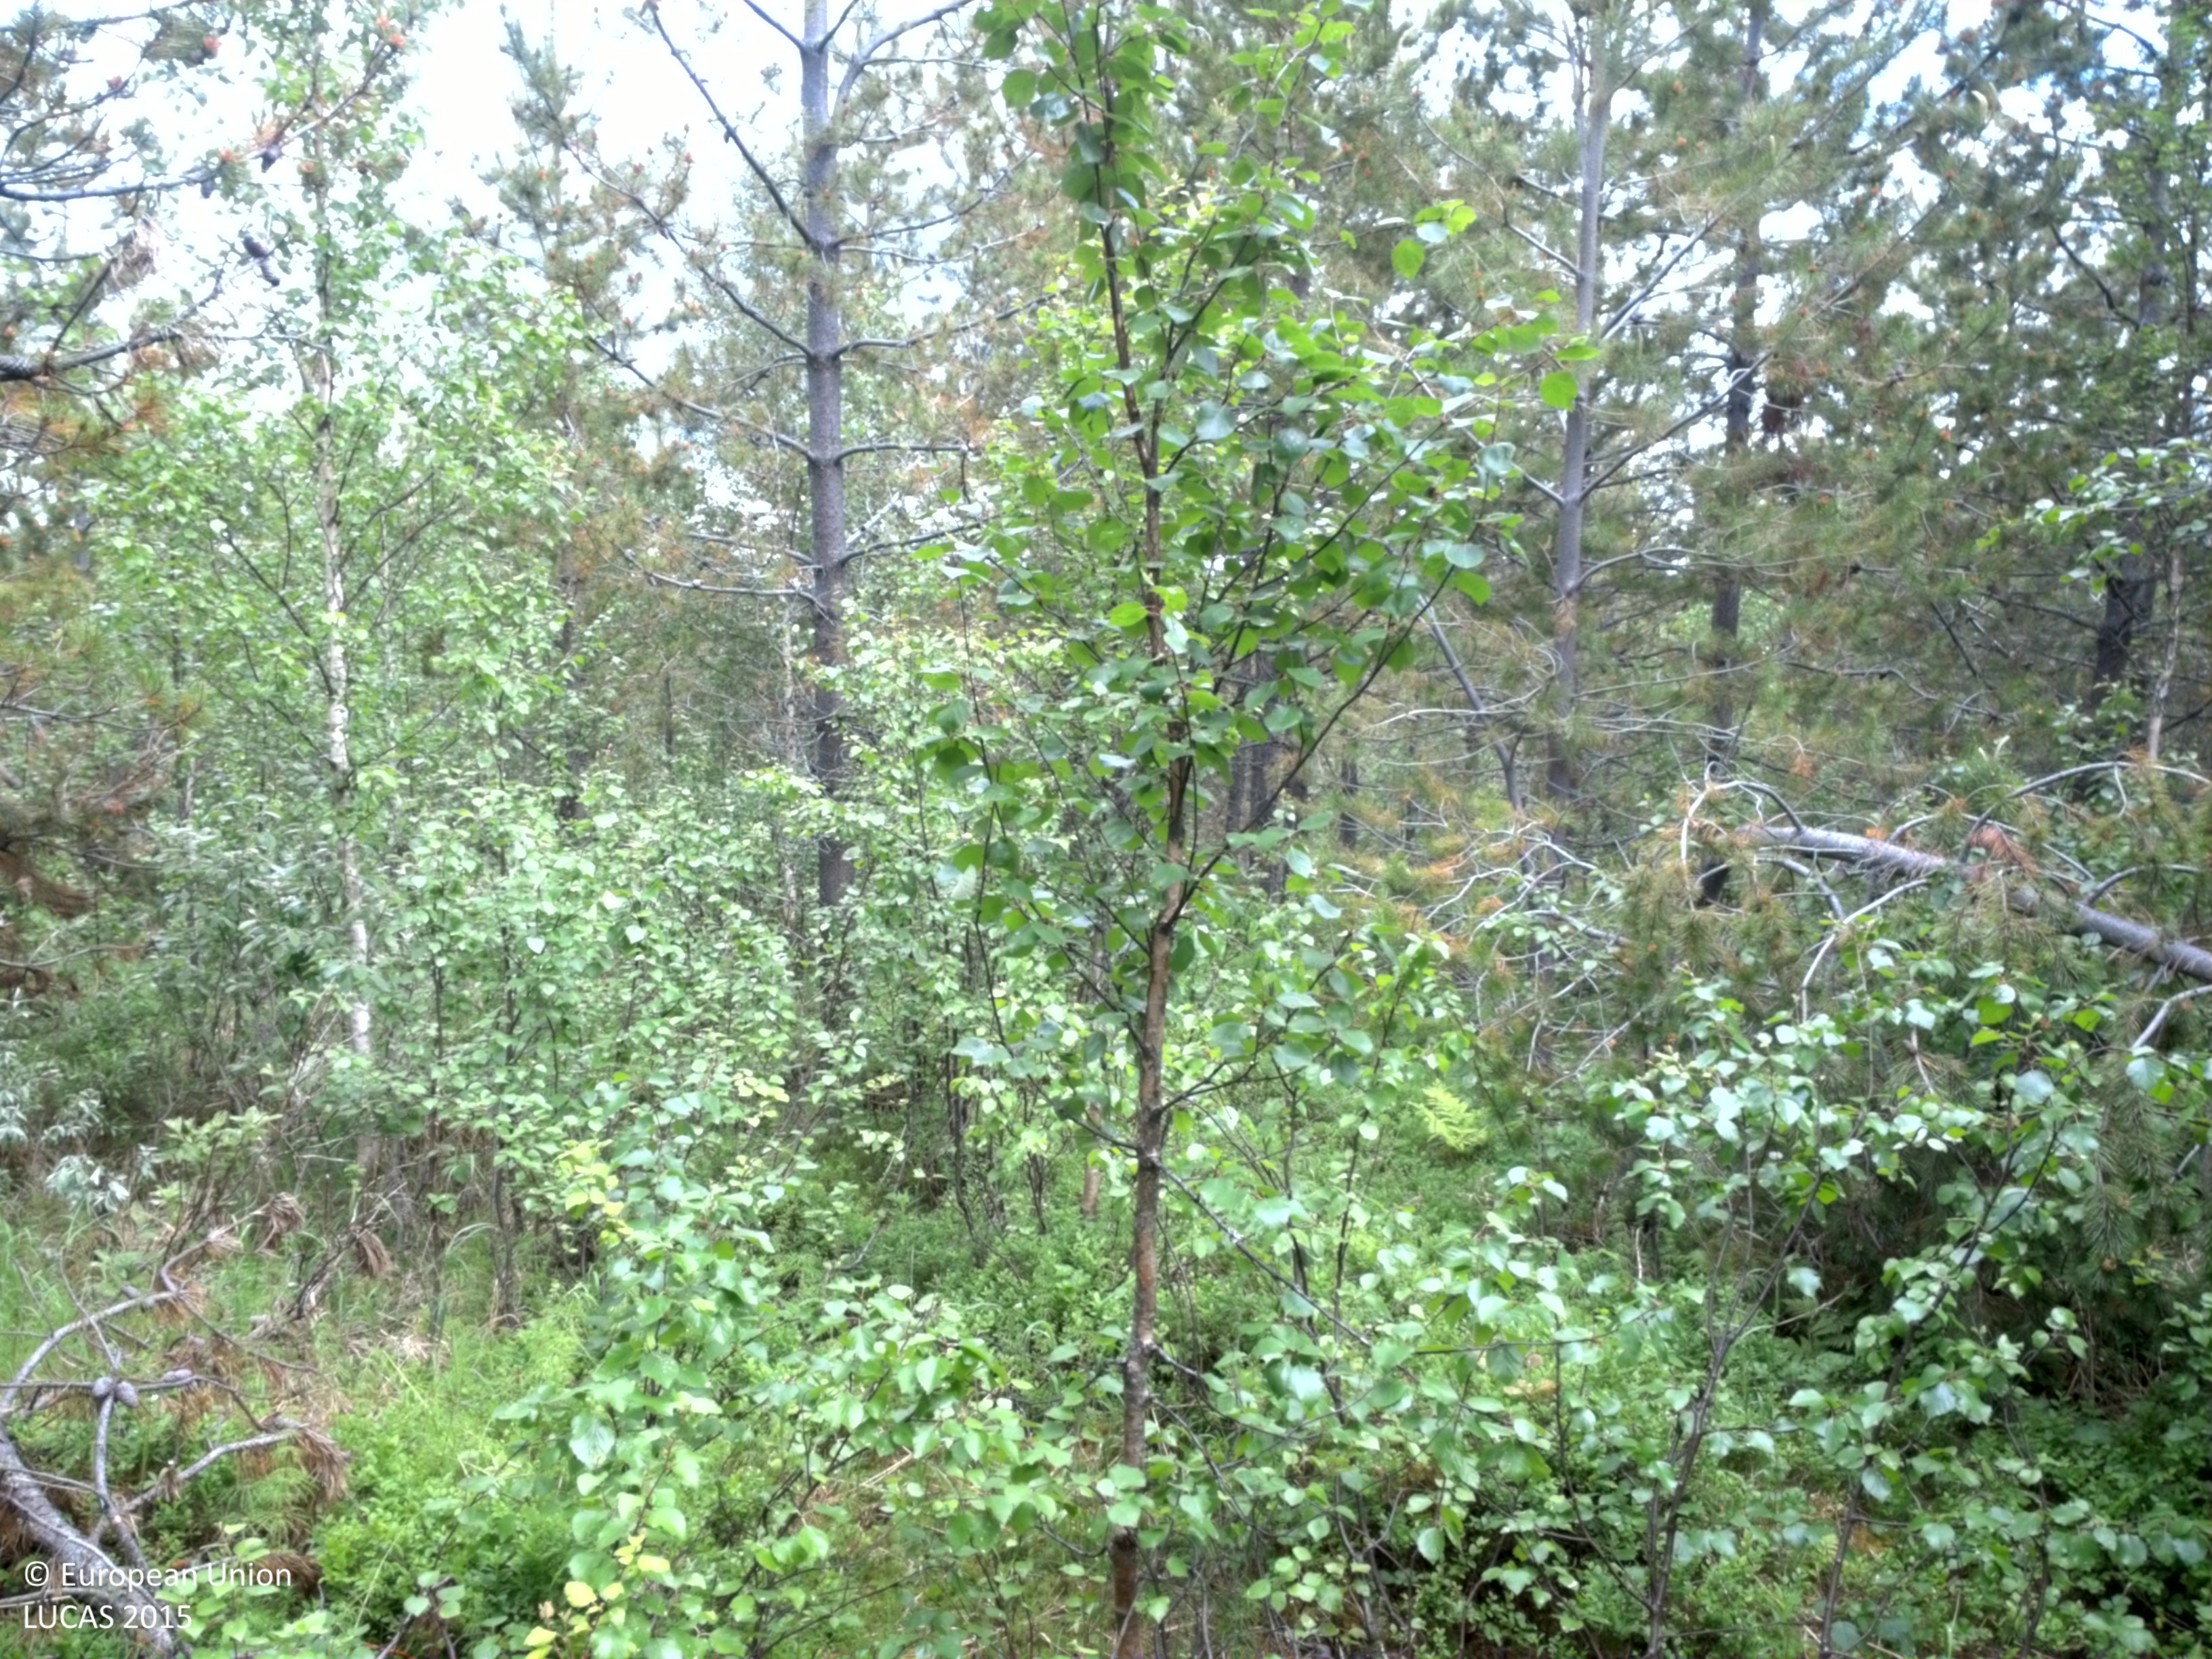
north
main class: Woodland
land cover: Pine dominated coniferous woodland
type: exotic forest
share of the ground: 50 - 75 %
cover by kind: coniferous forest trees 65 %, broadleaved forest trees 15 %, shrubs 15 %, herbaceous plants 5 %
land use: Forestry
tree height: > 5 m
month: July
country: SE
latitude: 64.4700
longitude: 17.9741
